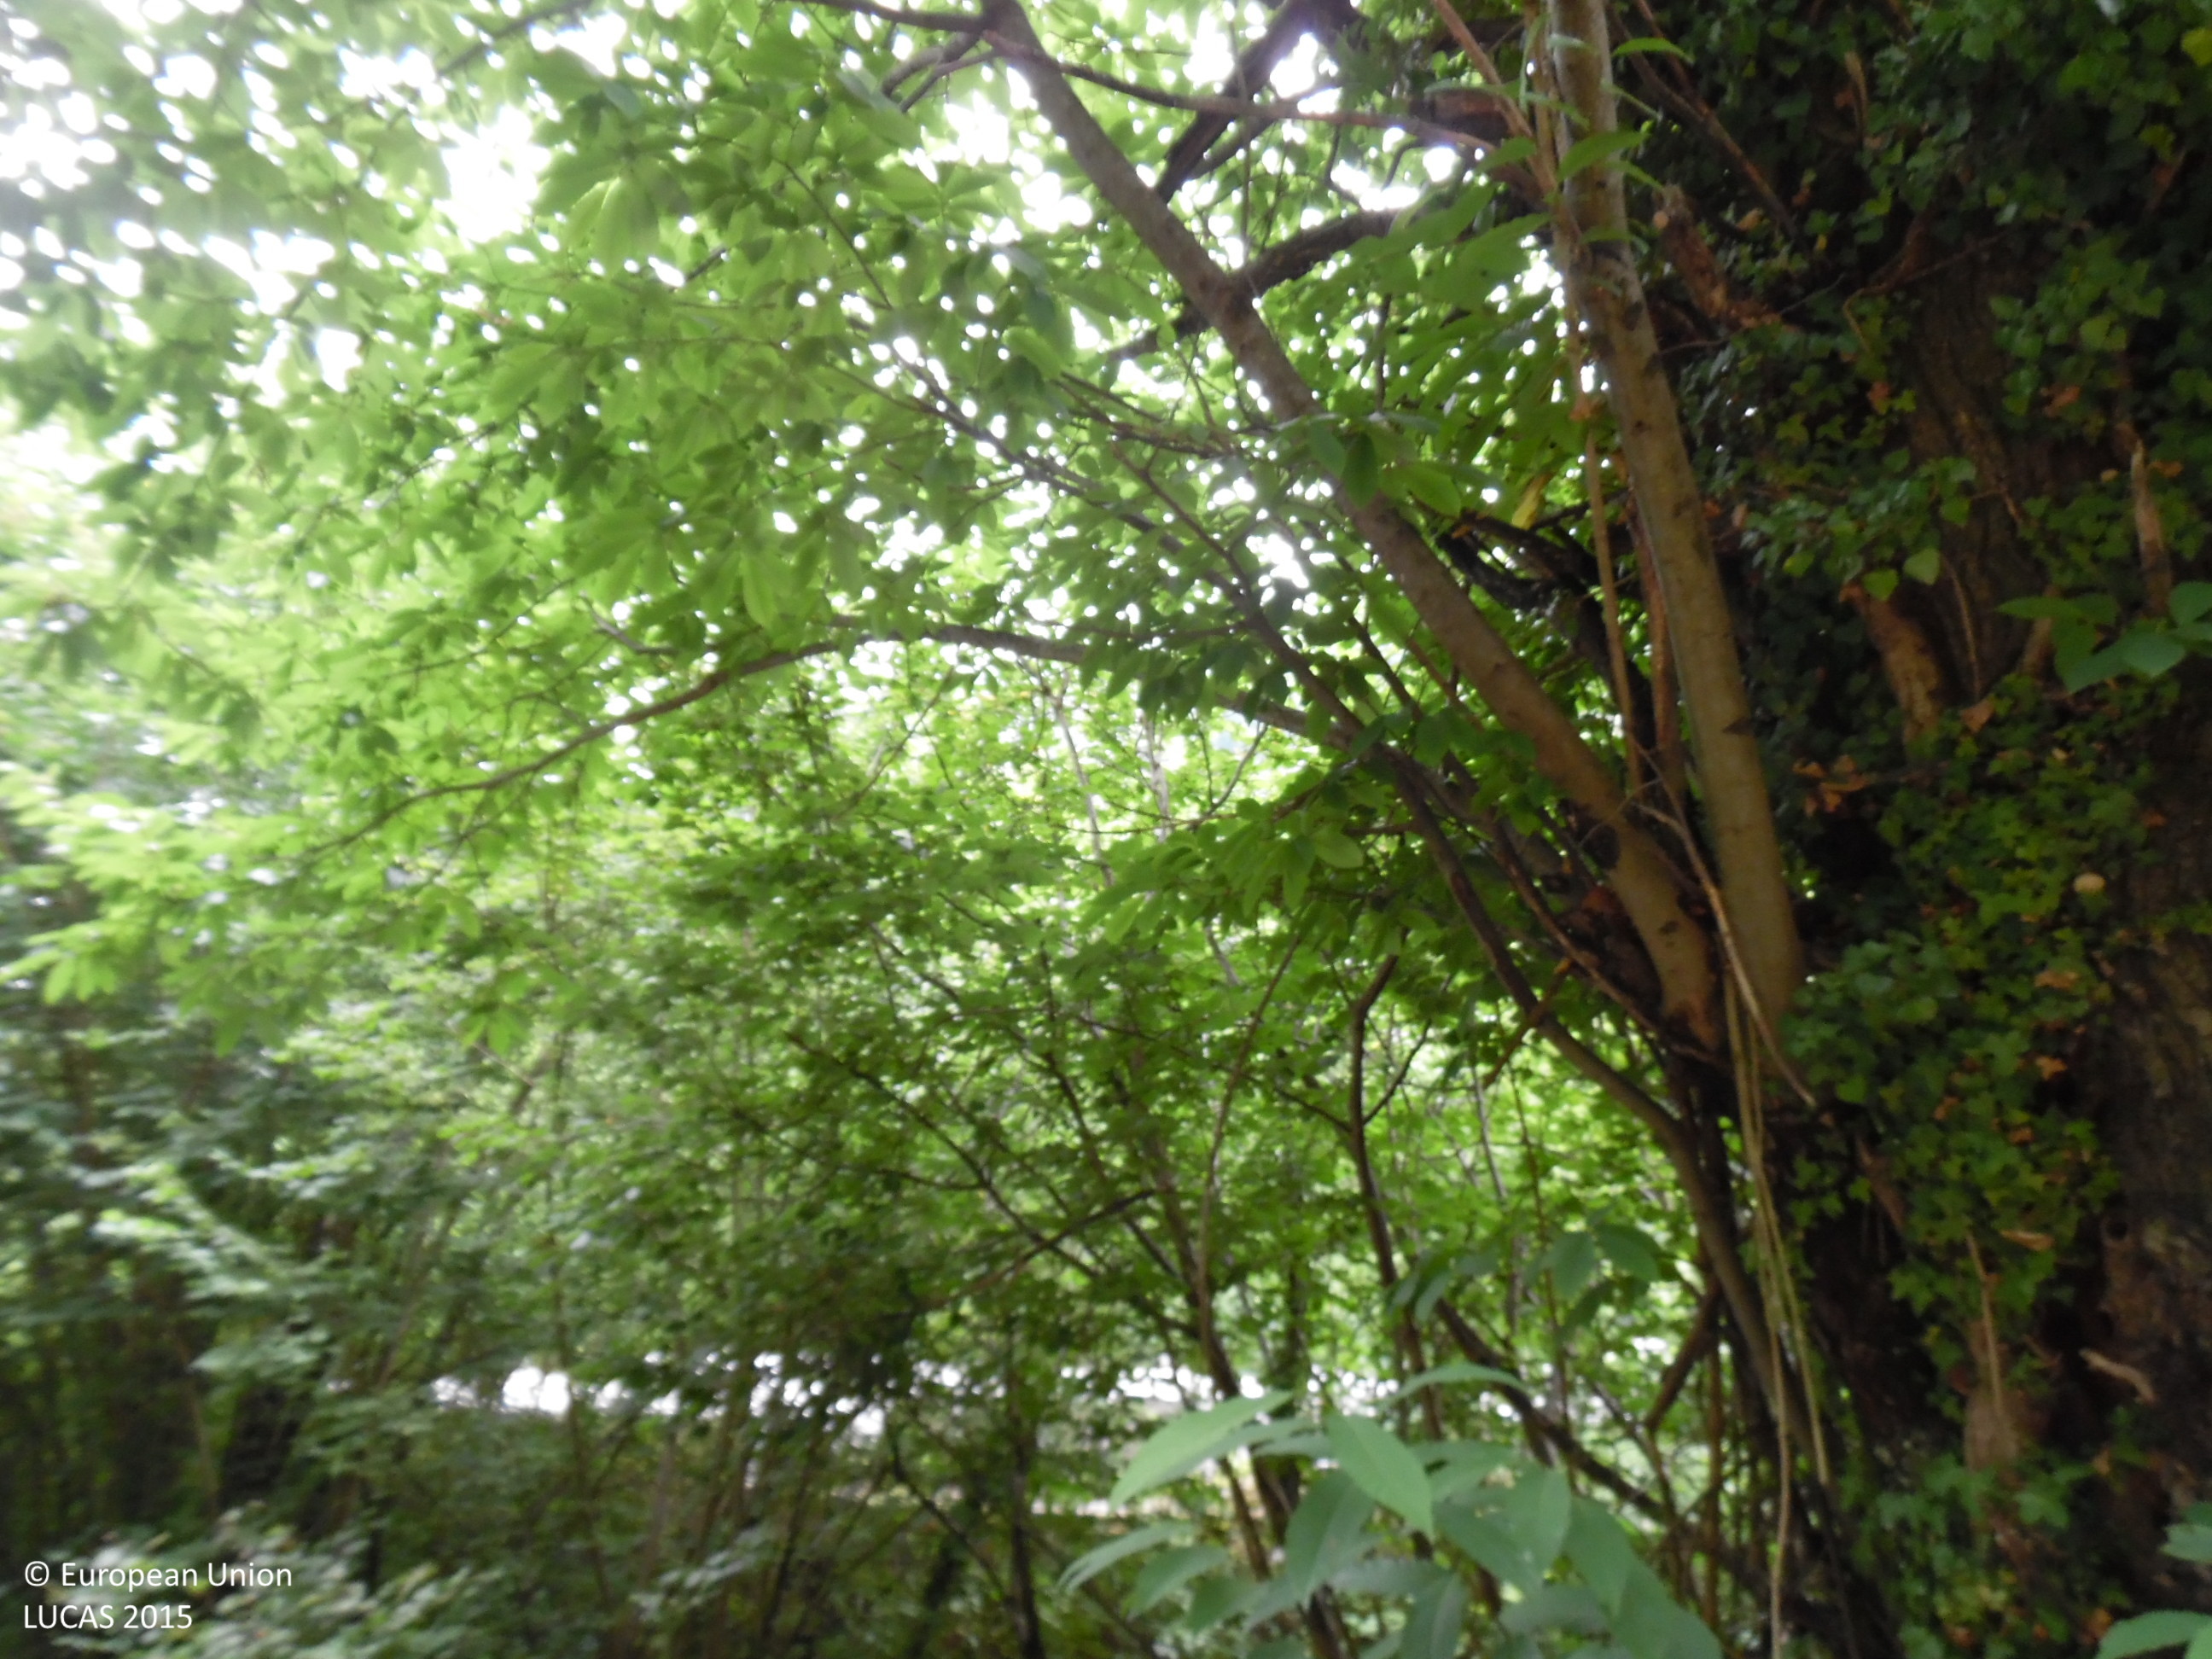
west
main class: Woodland
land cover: Broadleaved woodland
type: thermophilous deciduous forest
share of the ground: > 75 %
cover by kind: broadleaved forest trees 100 %
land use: Forestry
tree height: > 5 m
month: July
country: ES
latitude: 43.0343
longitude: -5.8305
